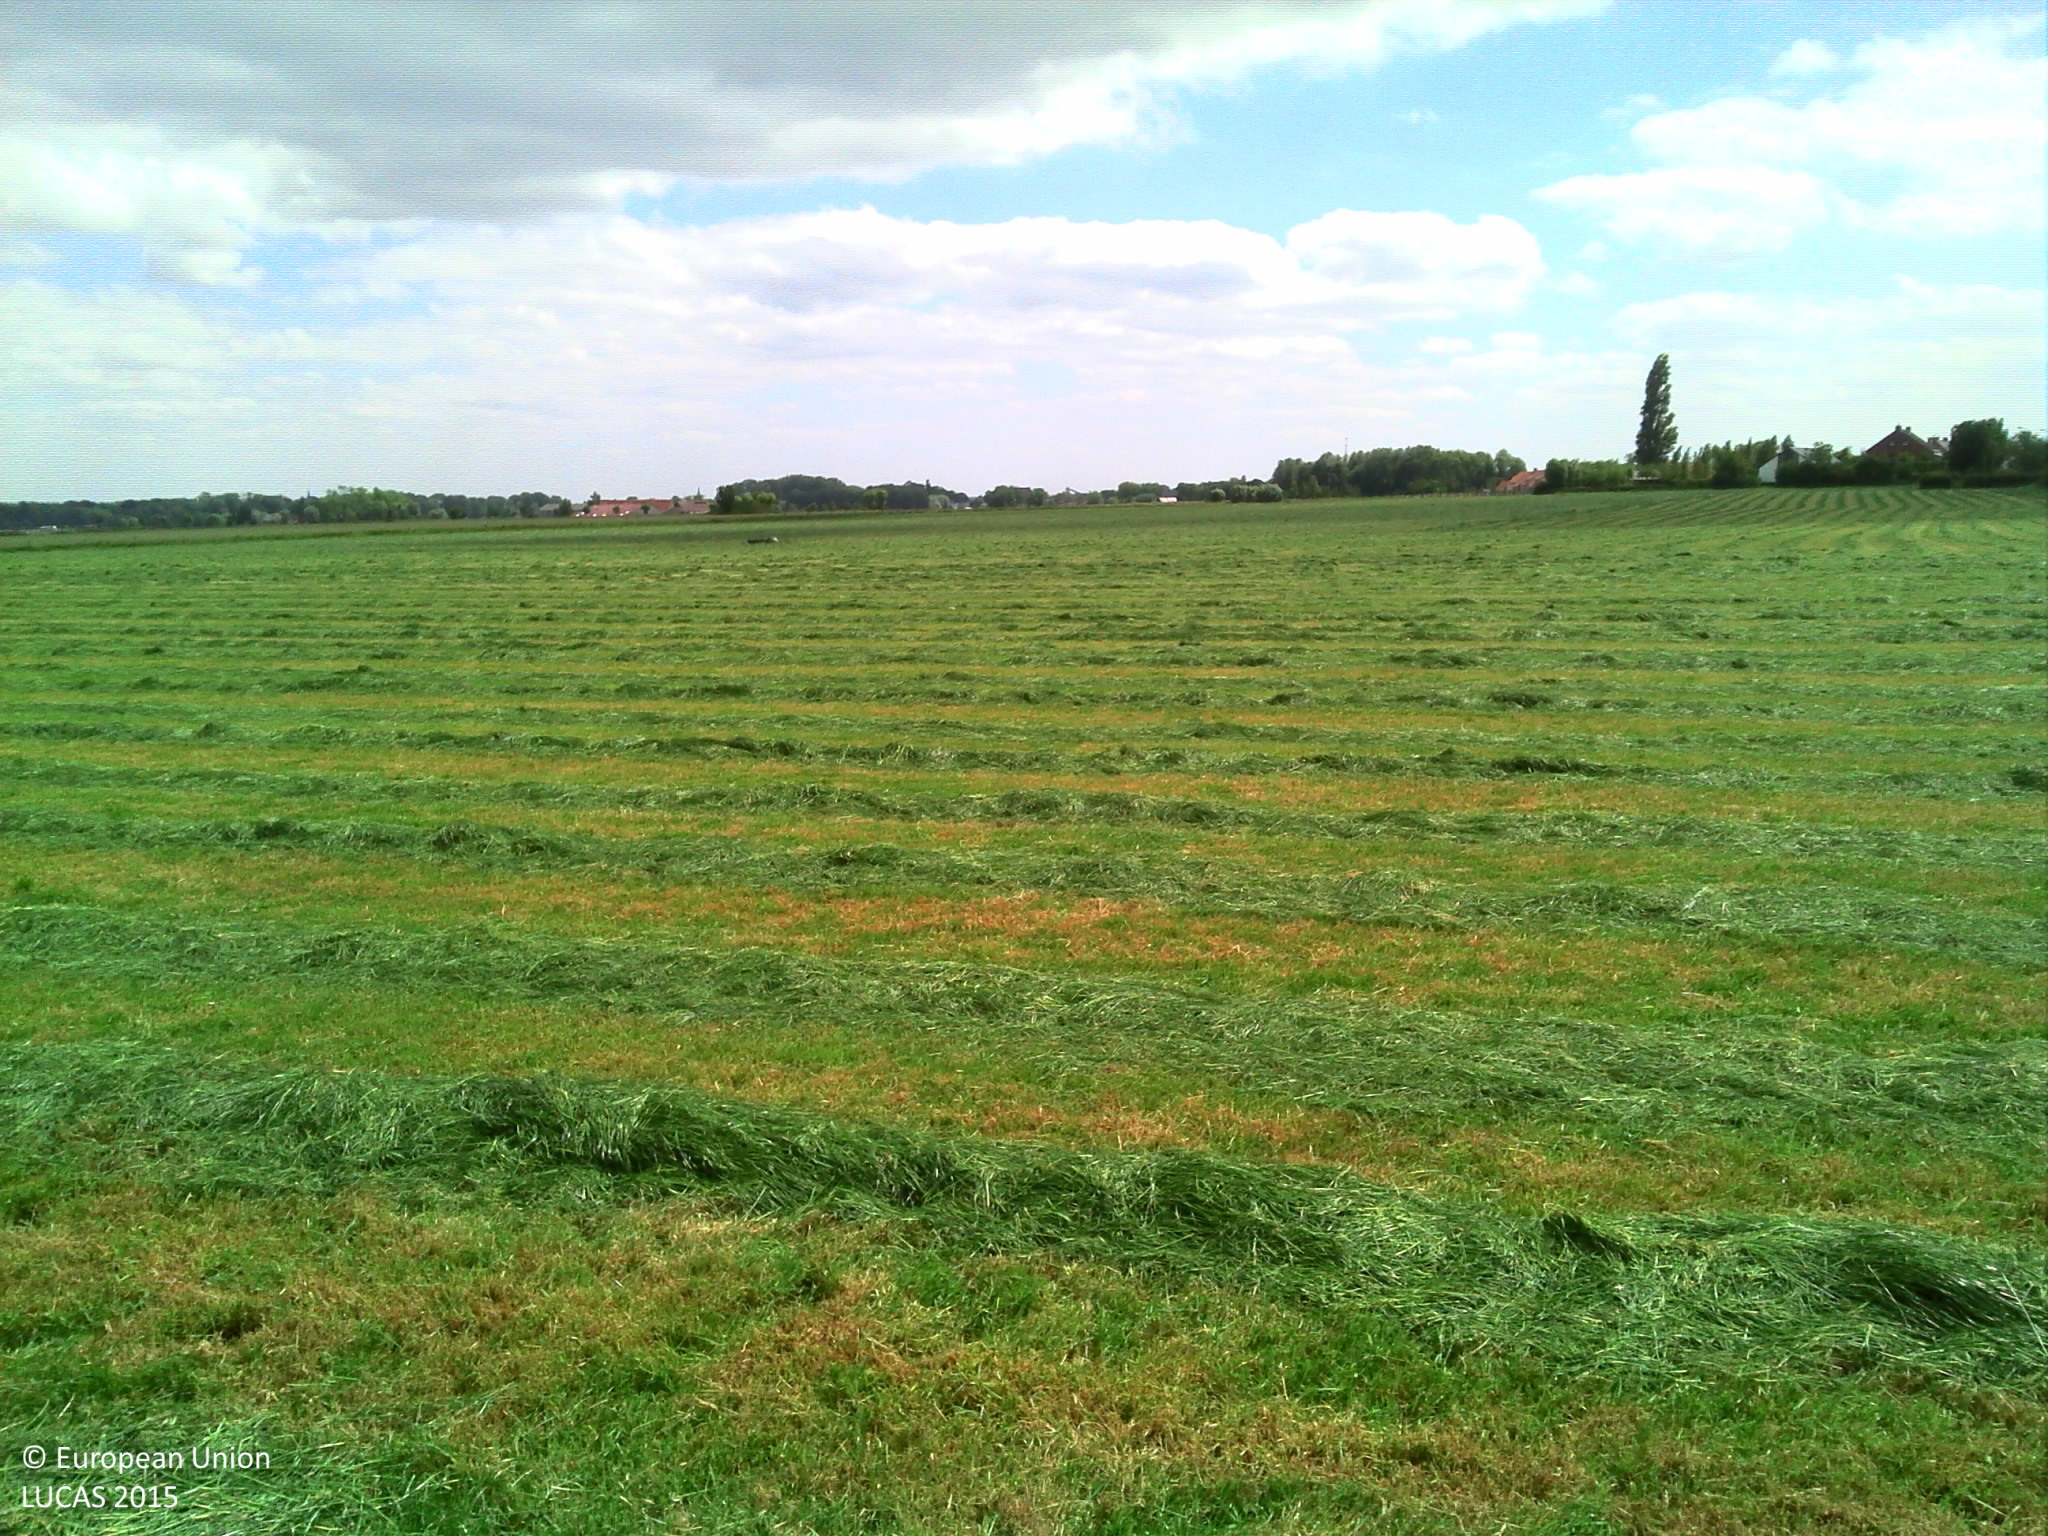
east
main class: Cropland
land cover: Temporary grasslands
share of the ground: > 75 %
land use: Agriculture (excluding fallow land and kitchen gardens)
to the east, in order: Temporary grasslands
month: June
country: BE
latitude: 50.8583
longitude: 2.7862
